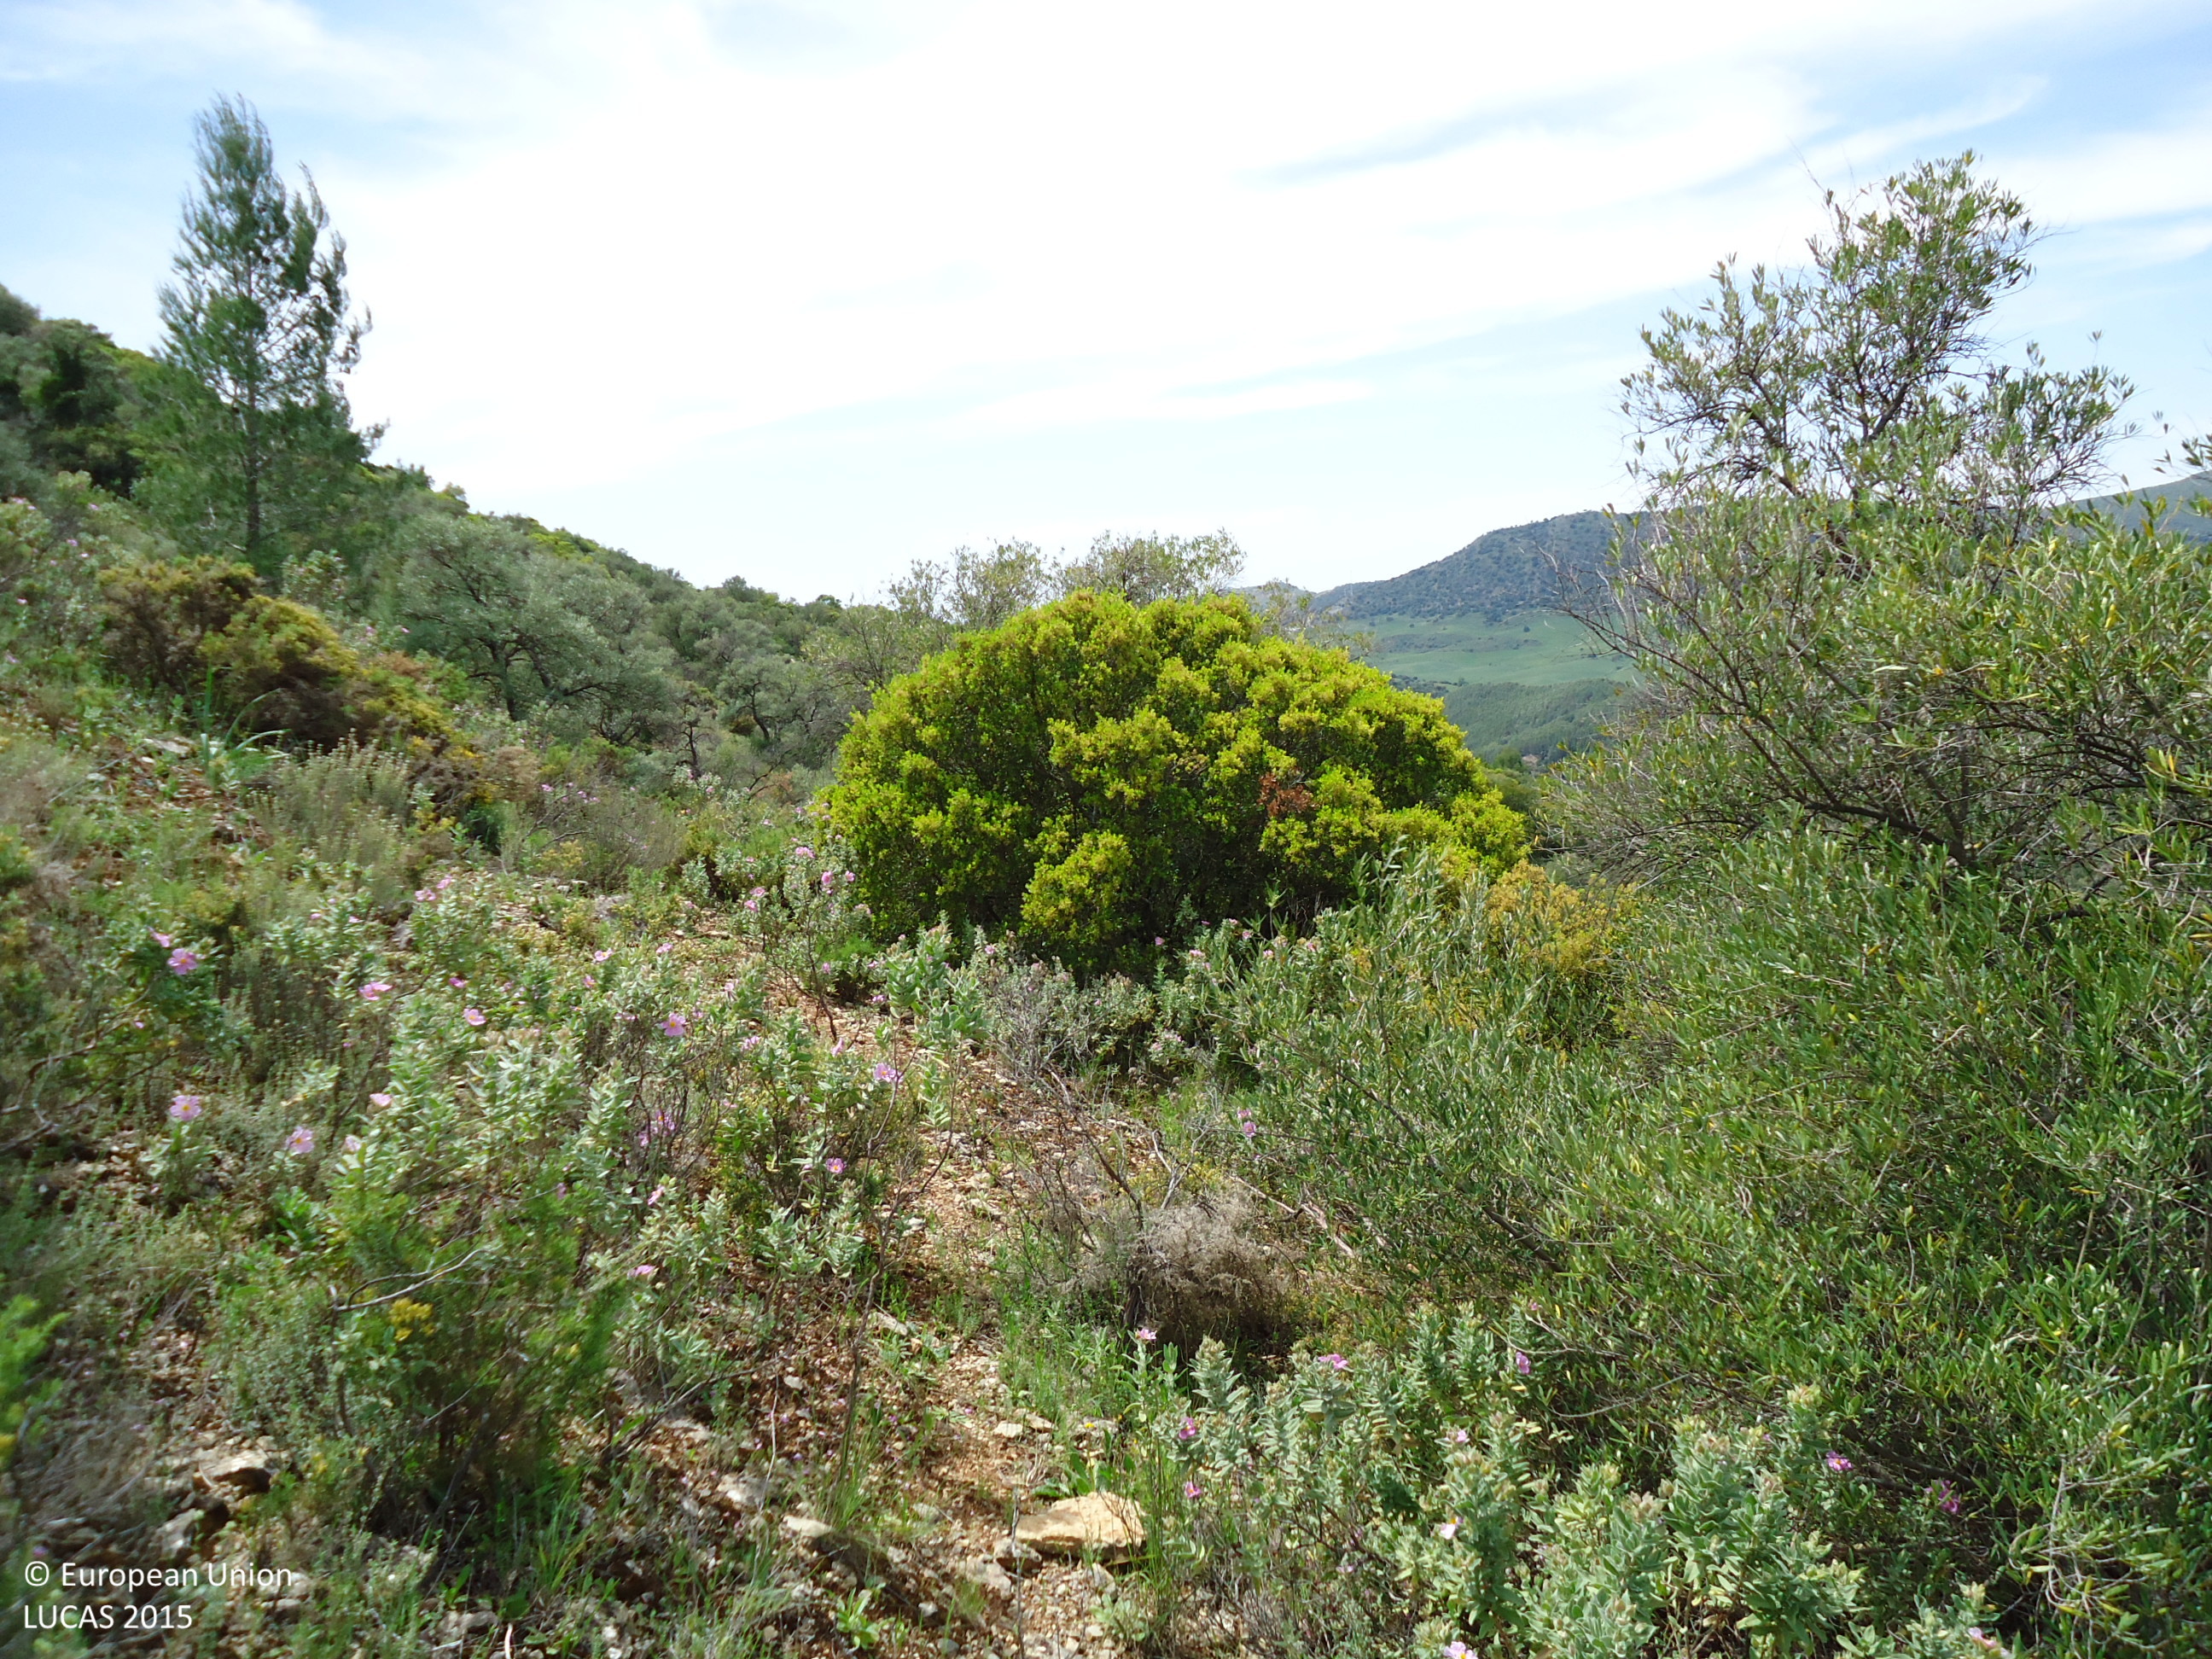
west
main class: Shrubland
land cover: Shrubland with sparse tree cover
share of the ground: > 75 %
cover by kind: shrubs 85 %, herbaceous plants 10 %, coniferous forest trees 5 %
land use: Semi-natural and natural areas not in use
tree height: > 5 m
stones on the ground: > 50 %
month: April
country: ES
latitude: 36.9025
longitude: -5.4372
